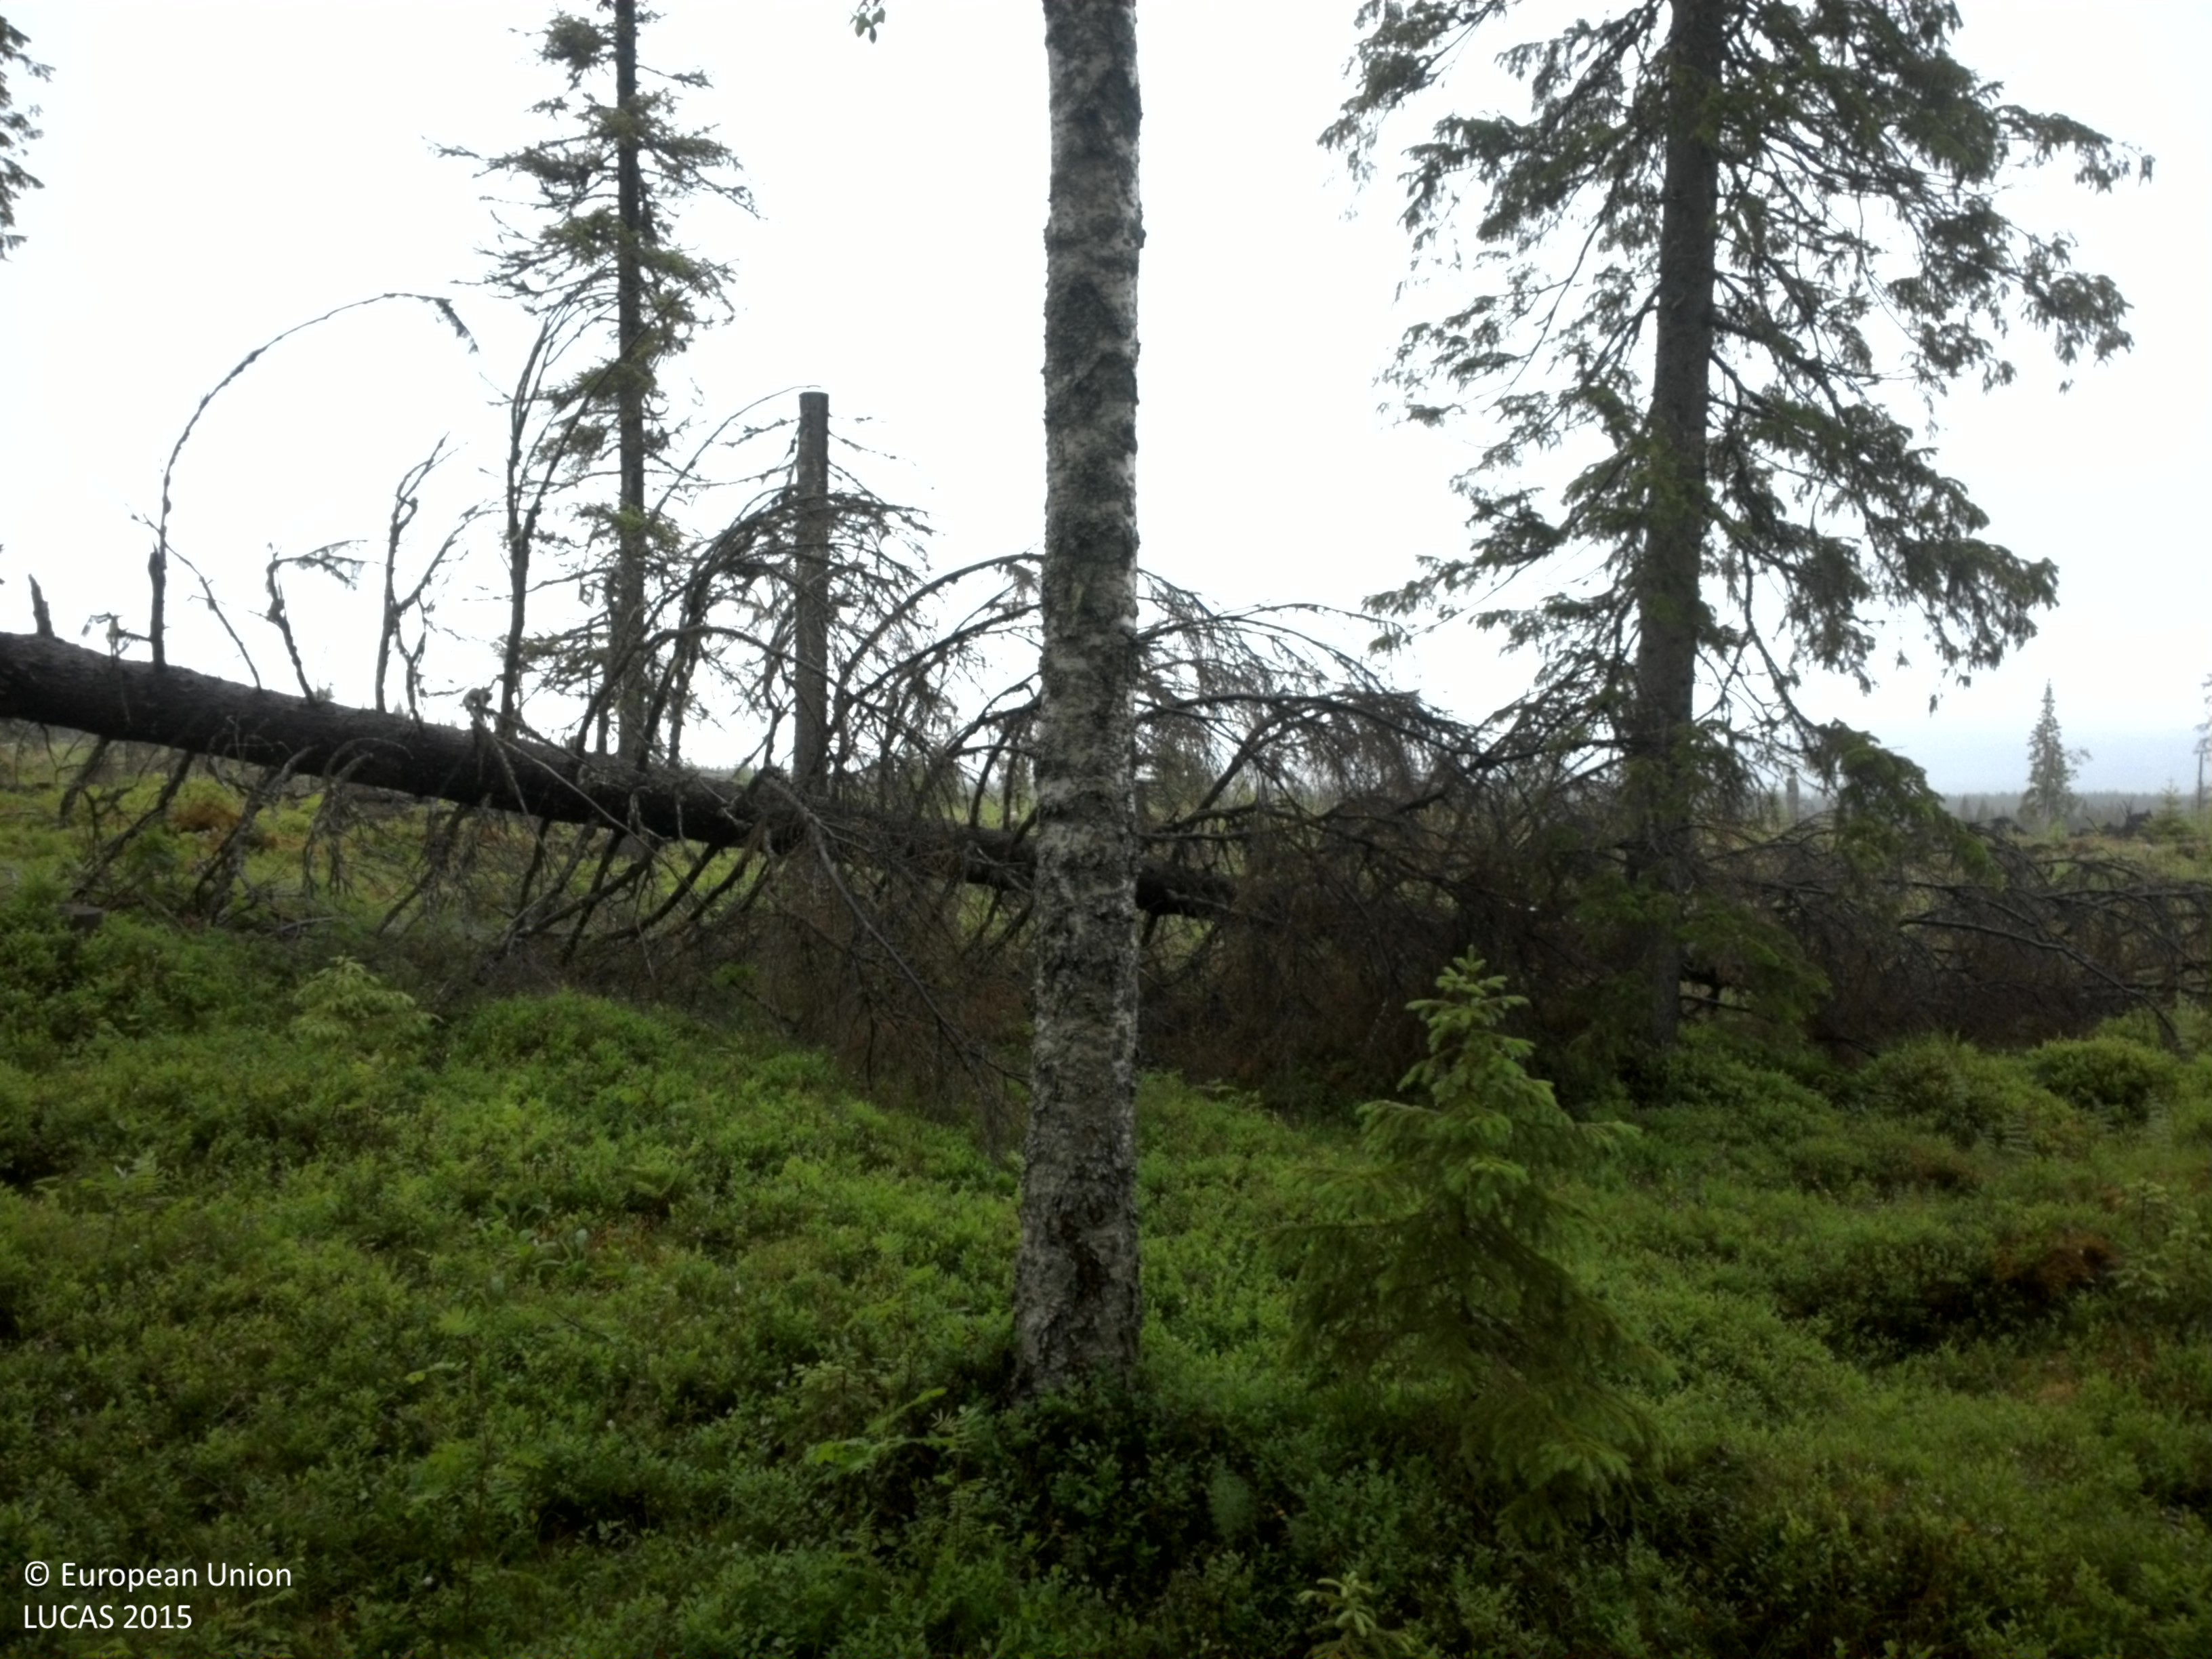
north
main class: Woodland
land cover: Spruce dominated mixed woodland
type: boreal forest
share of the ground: 50 - 75 %
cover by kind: coniferous forest trees 45 %, shrubs 35 %, broadleaved forest trees 15 %, herbaceous plants 5 %
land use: Forestry
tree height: > 5 m
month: July
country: SE
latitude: 64.5733
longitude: 18.0872
